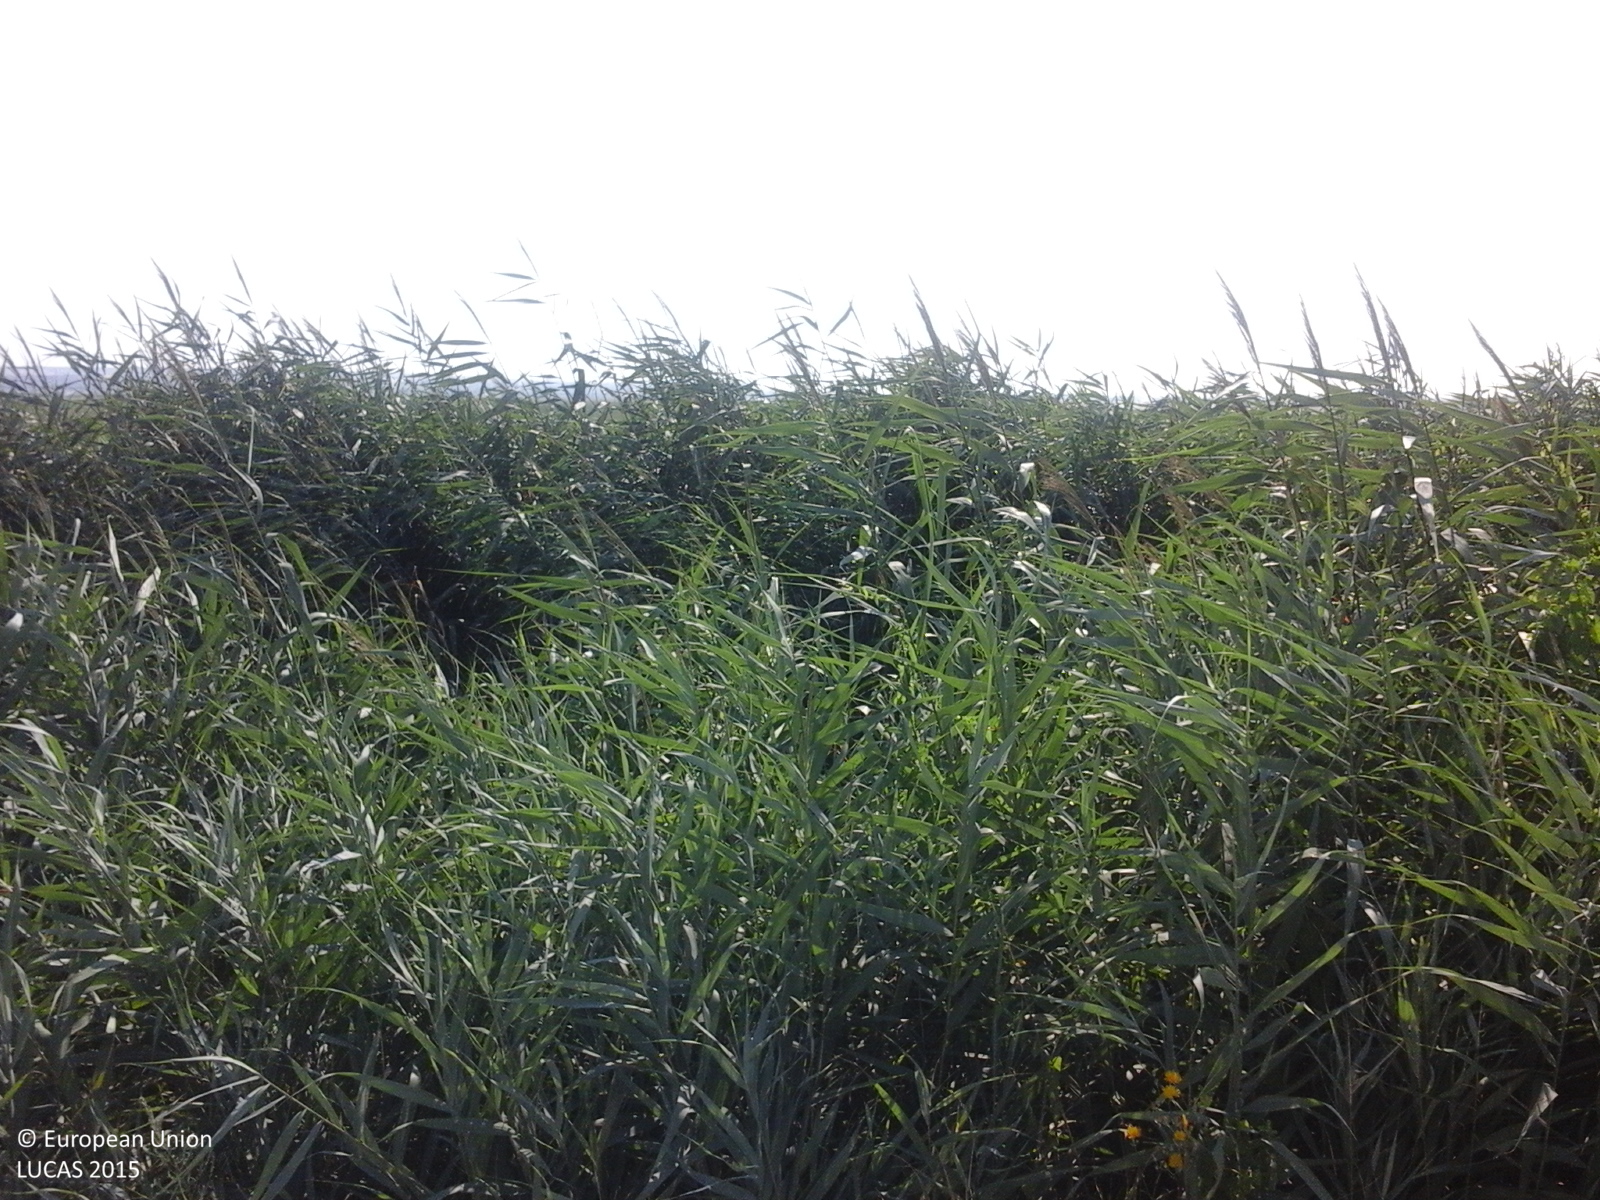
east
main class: Cropland
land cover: Maize
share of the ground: > 75 %
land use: Agriculture (excluding fallow land and kitchen gardens)
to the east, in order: Maize
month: July
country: RO
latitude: 45.4695
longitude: 28.1177
